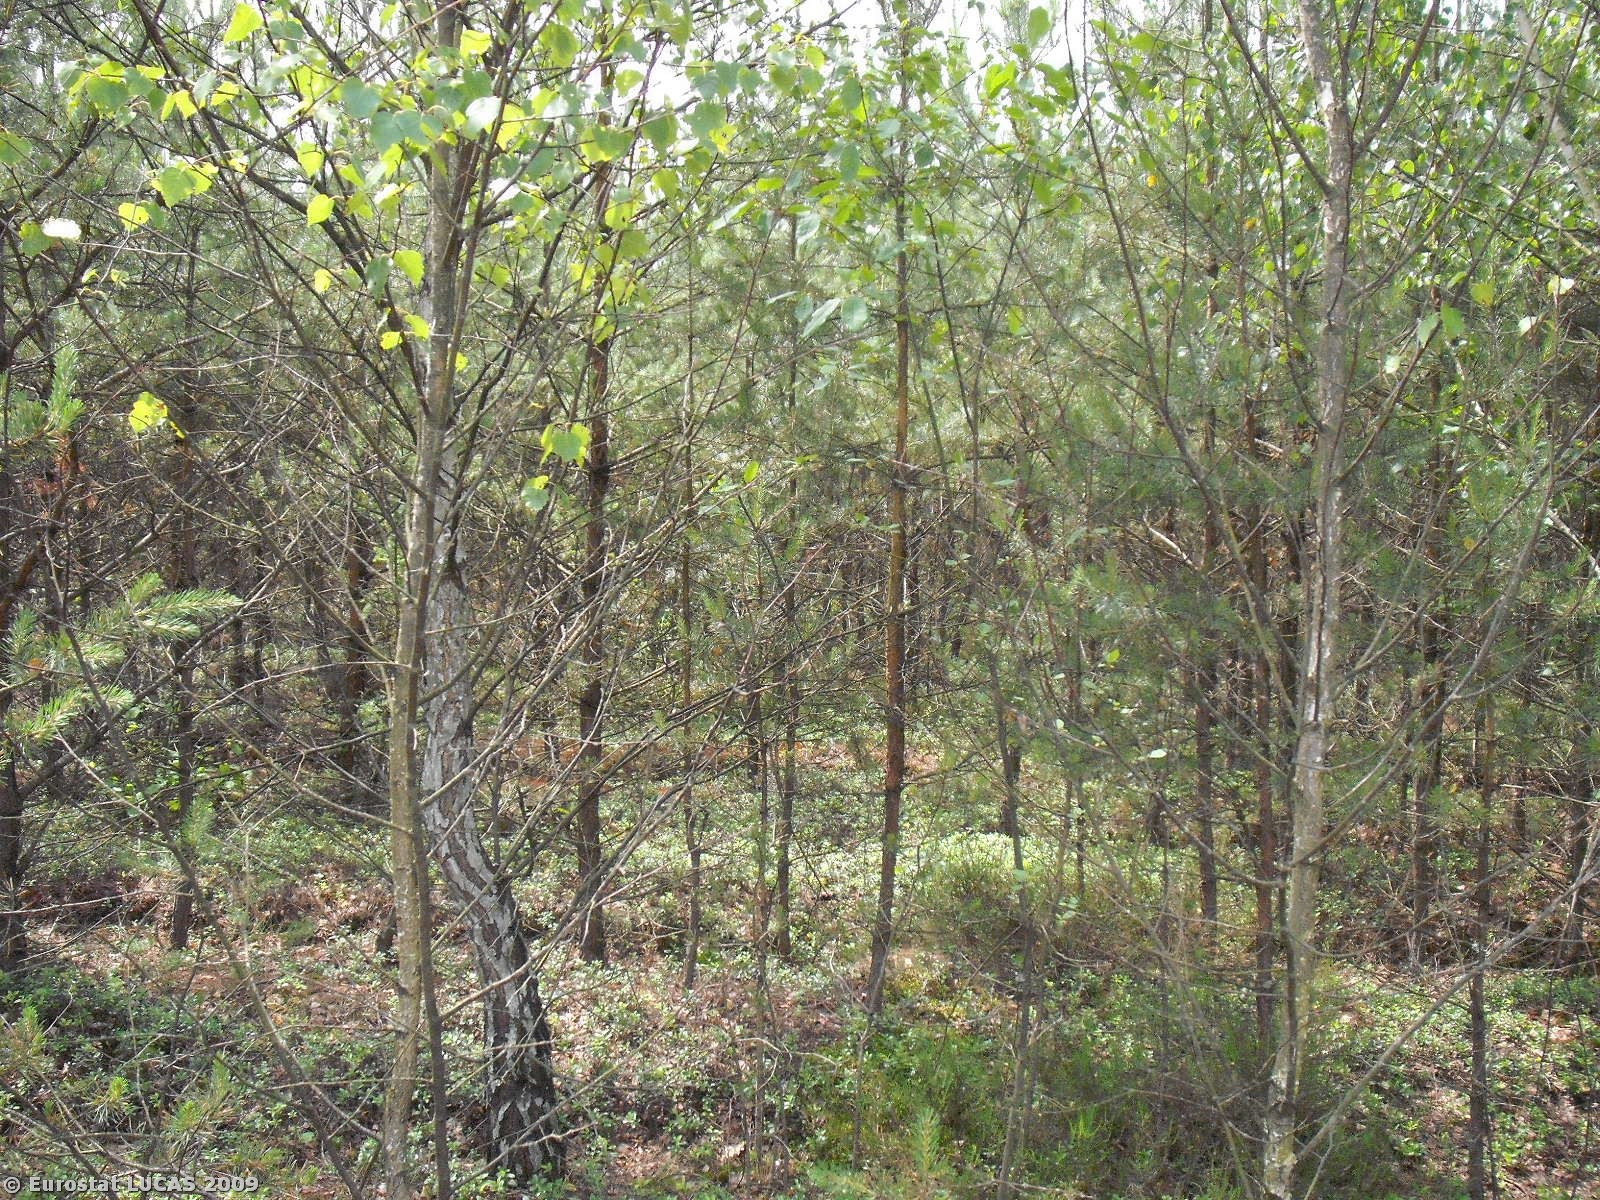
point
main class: Woodland
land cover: Coniferous woodland
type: hemiboreal forest and nemoral coniferous forest and mixed broadleaved-coniferous forest
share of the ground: > 75 %
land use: Forestry
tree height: > 5 m
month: June
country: PL
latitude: 51.2057
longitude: 20.4724
